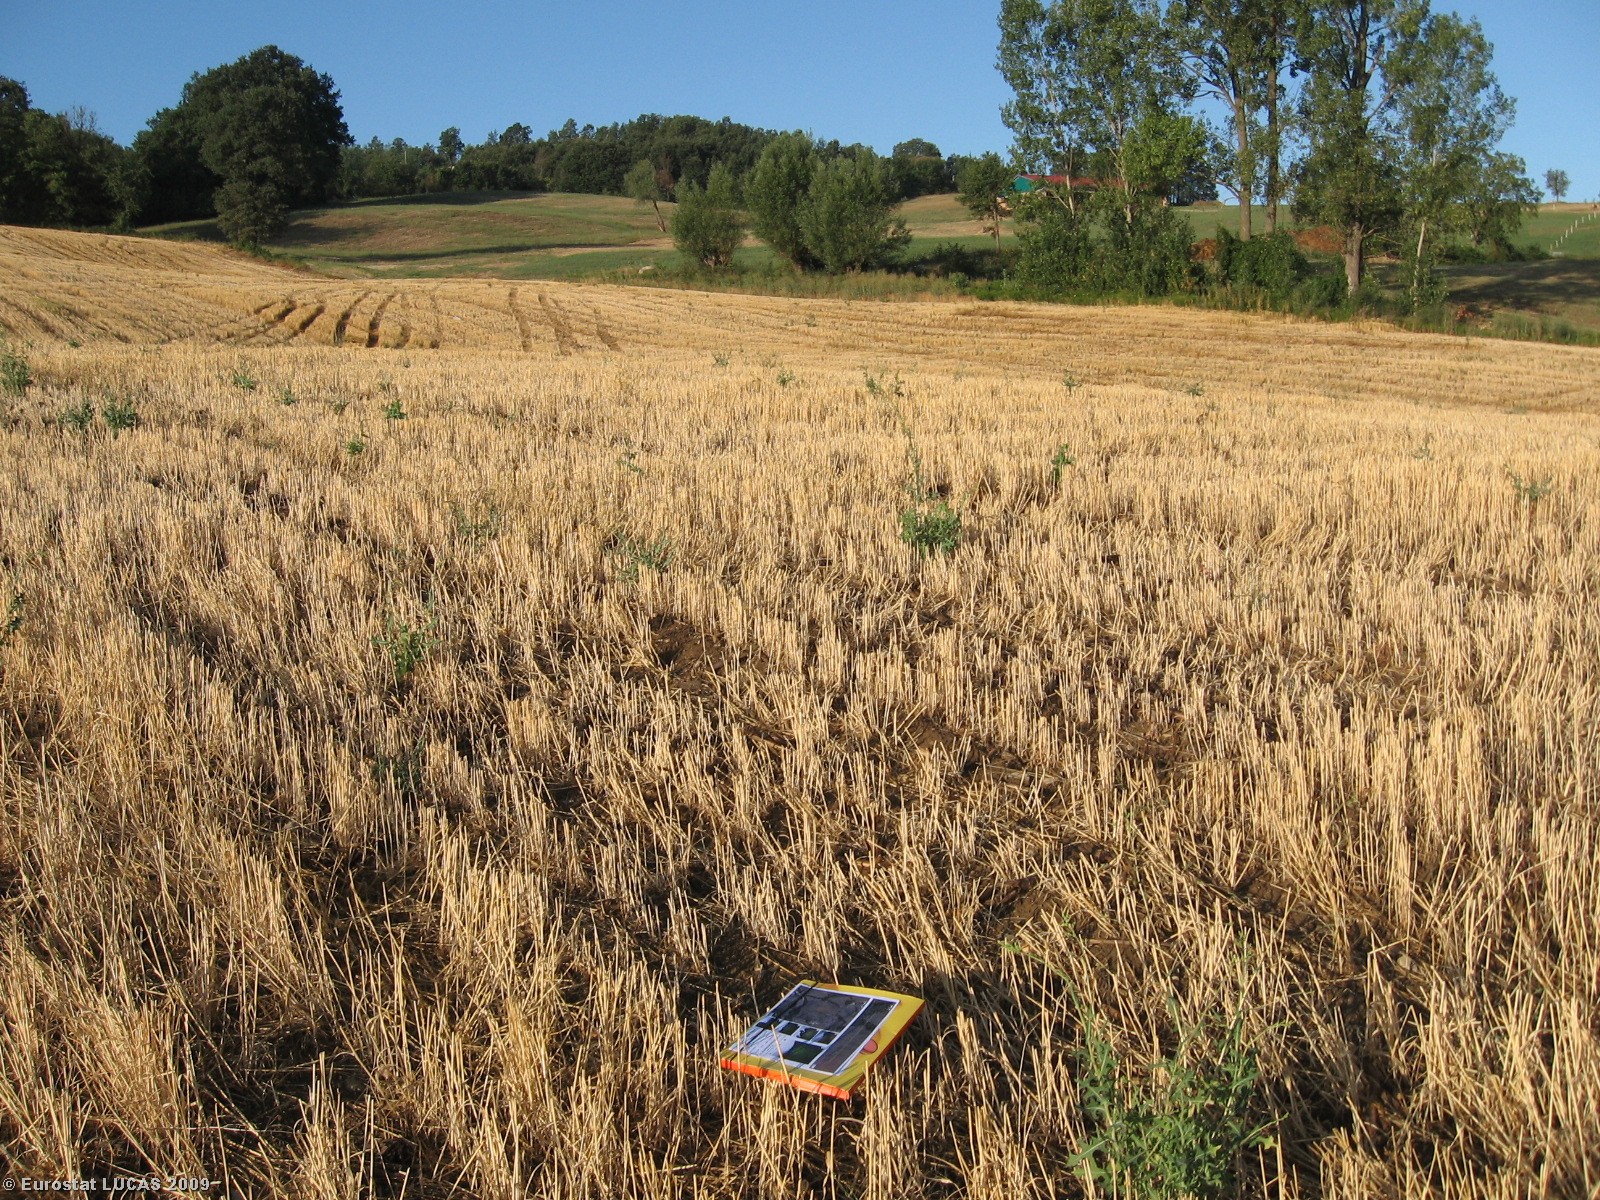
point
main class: Cropland
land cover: Common wheat
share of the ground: < 10 %
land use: Agriculture (excluding fallow land and kitchen gardens)
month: August
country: IT
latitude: 44.9264
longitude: 9.5069
